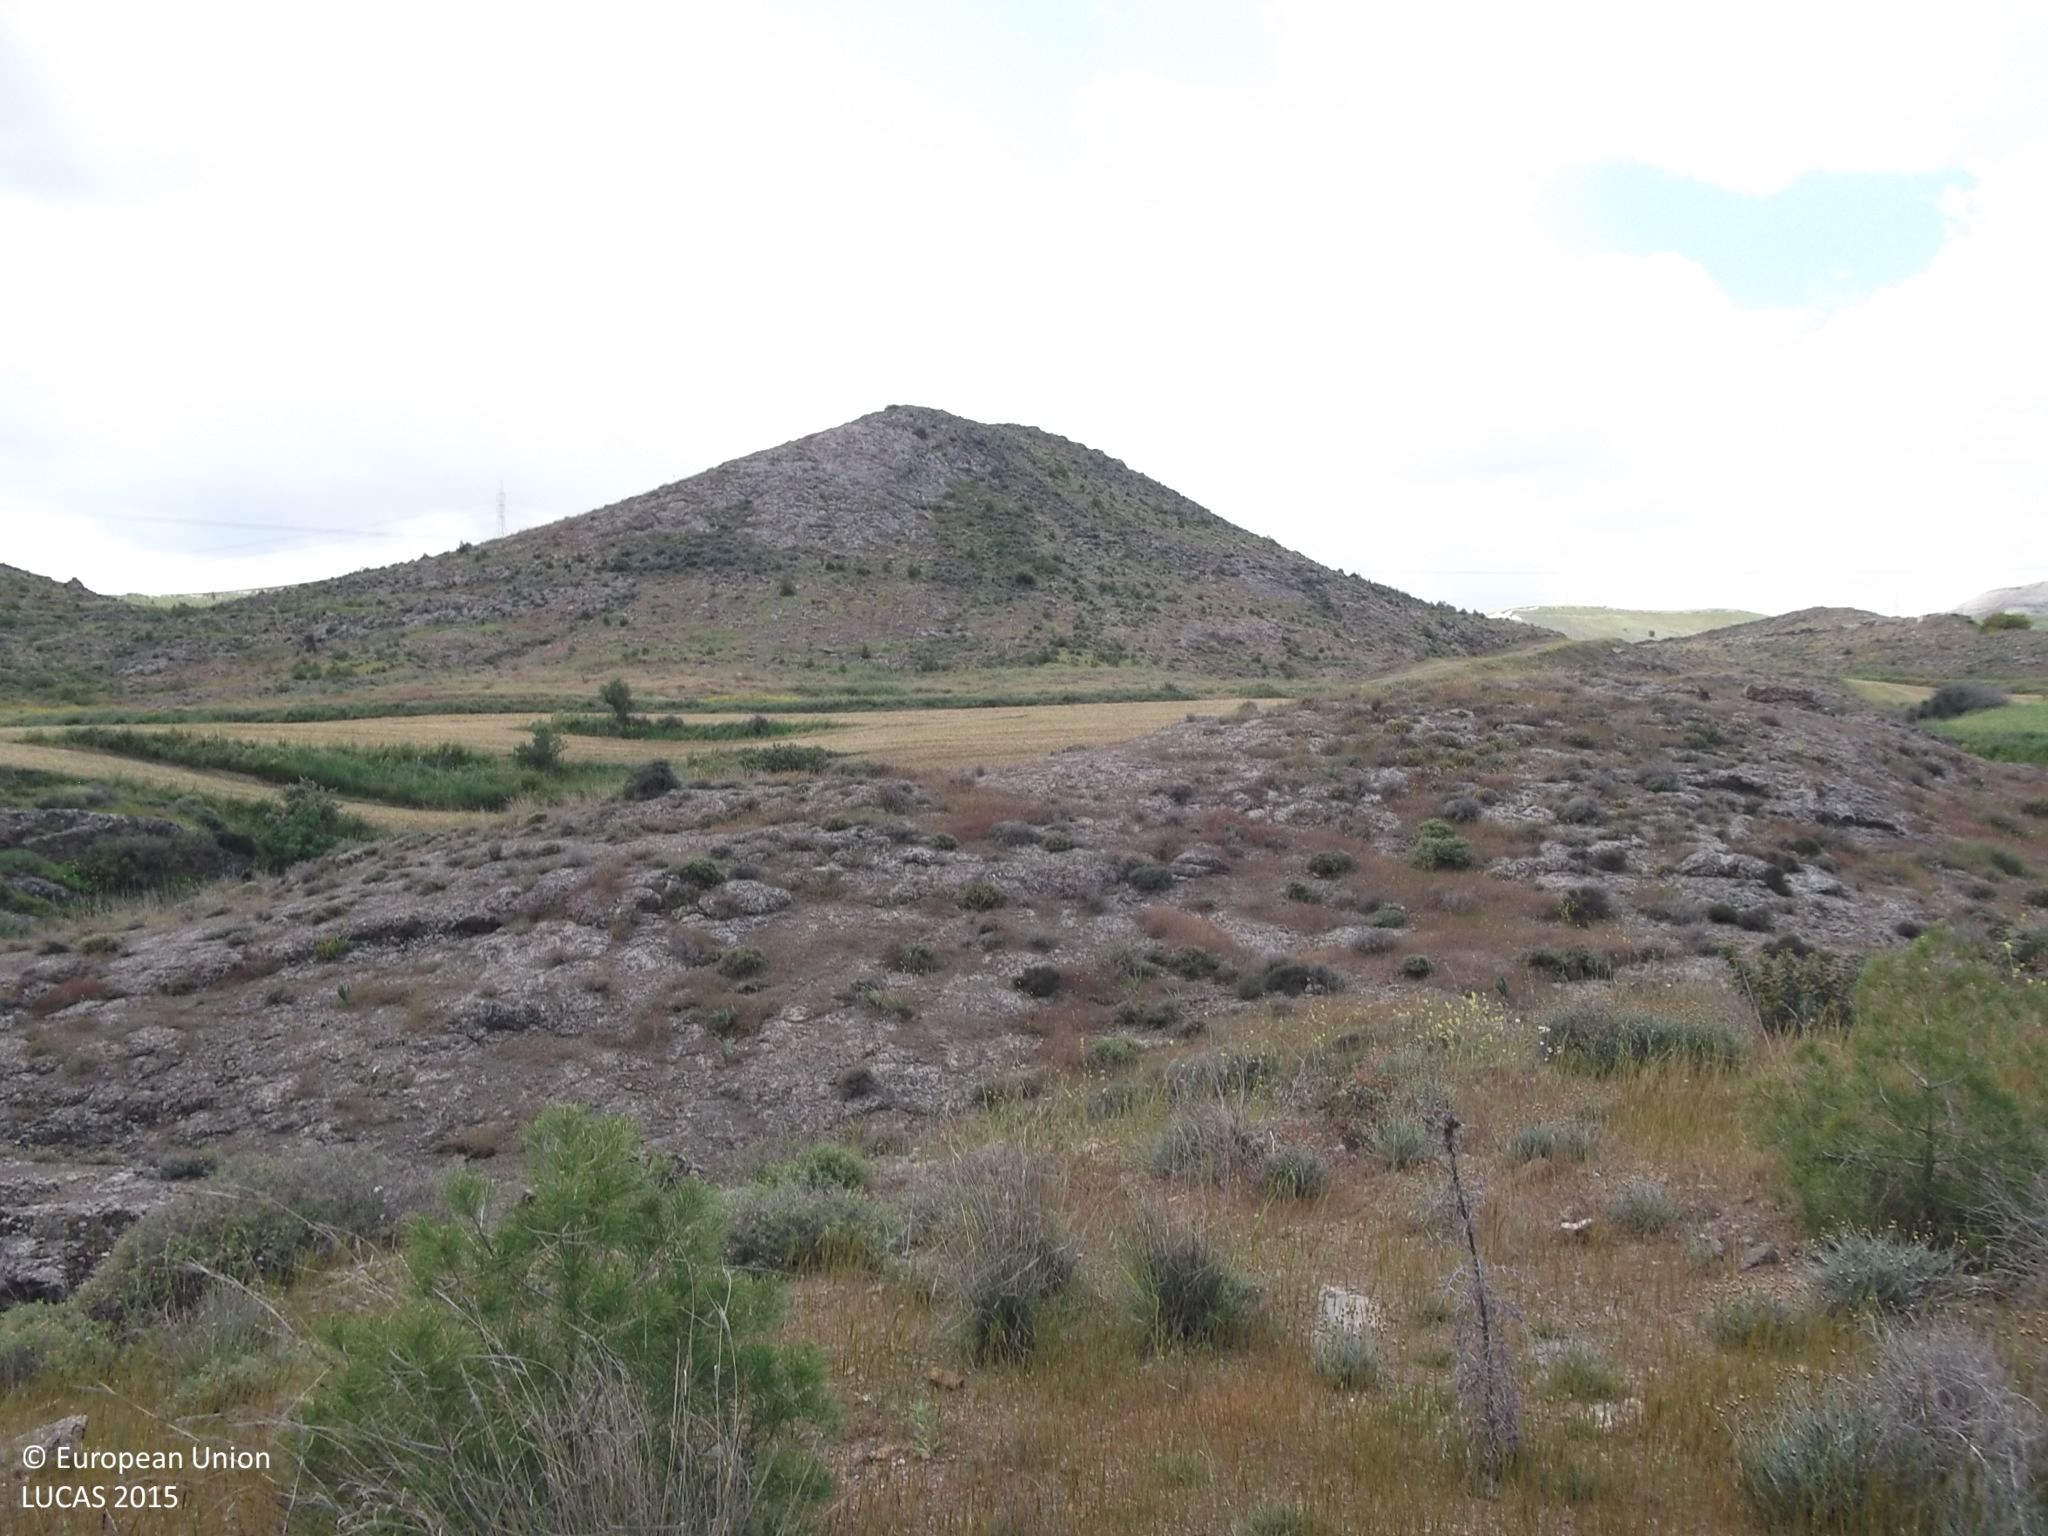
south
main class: Shrubland
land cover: Shrubland with sparse tree cover
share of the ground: 50 - 75 %
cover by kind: shrubs 55 %, herbaceous plants 30 %, consolidated bare surface 10 %, coniferous forest trees 5 %
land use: Semi-natural and natural areas not in use
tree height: < 5 m
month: April
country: CY
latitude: 35.0034
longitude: 33.5686
